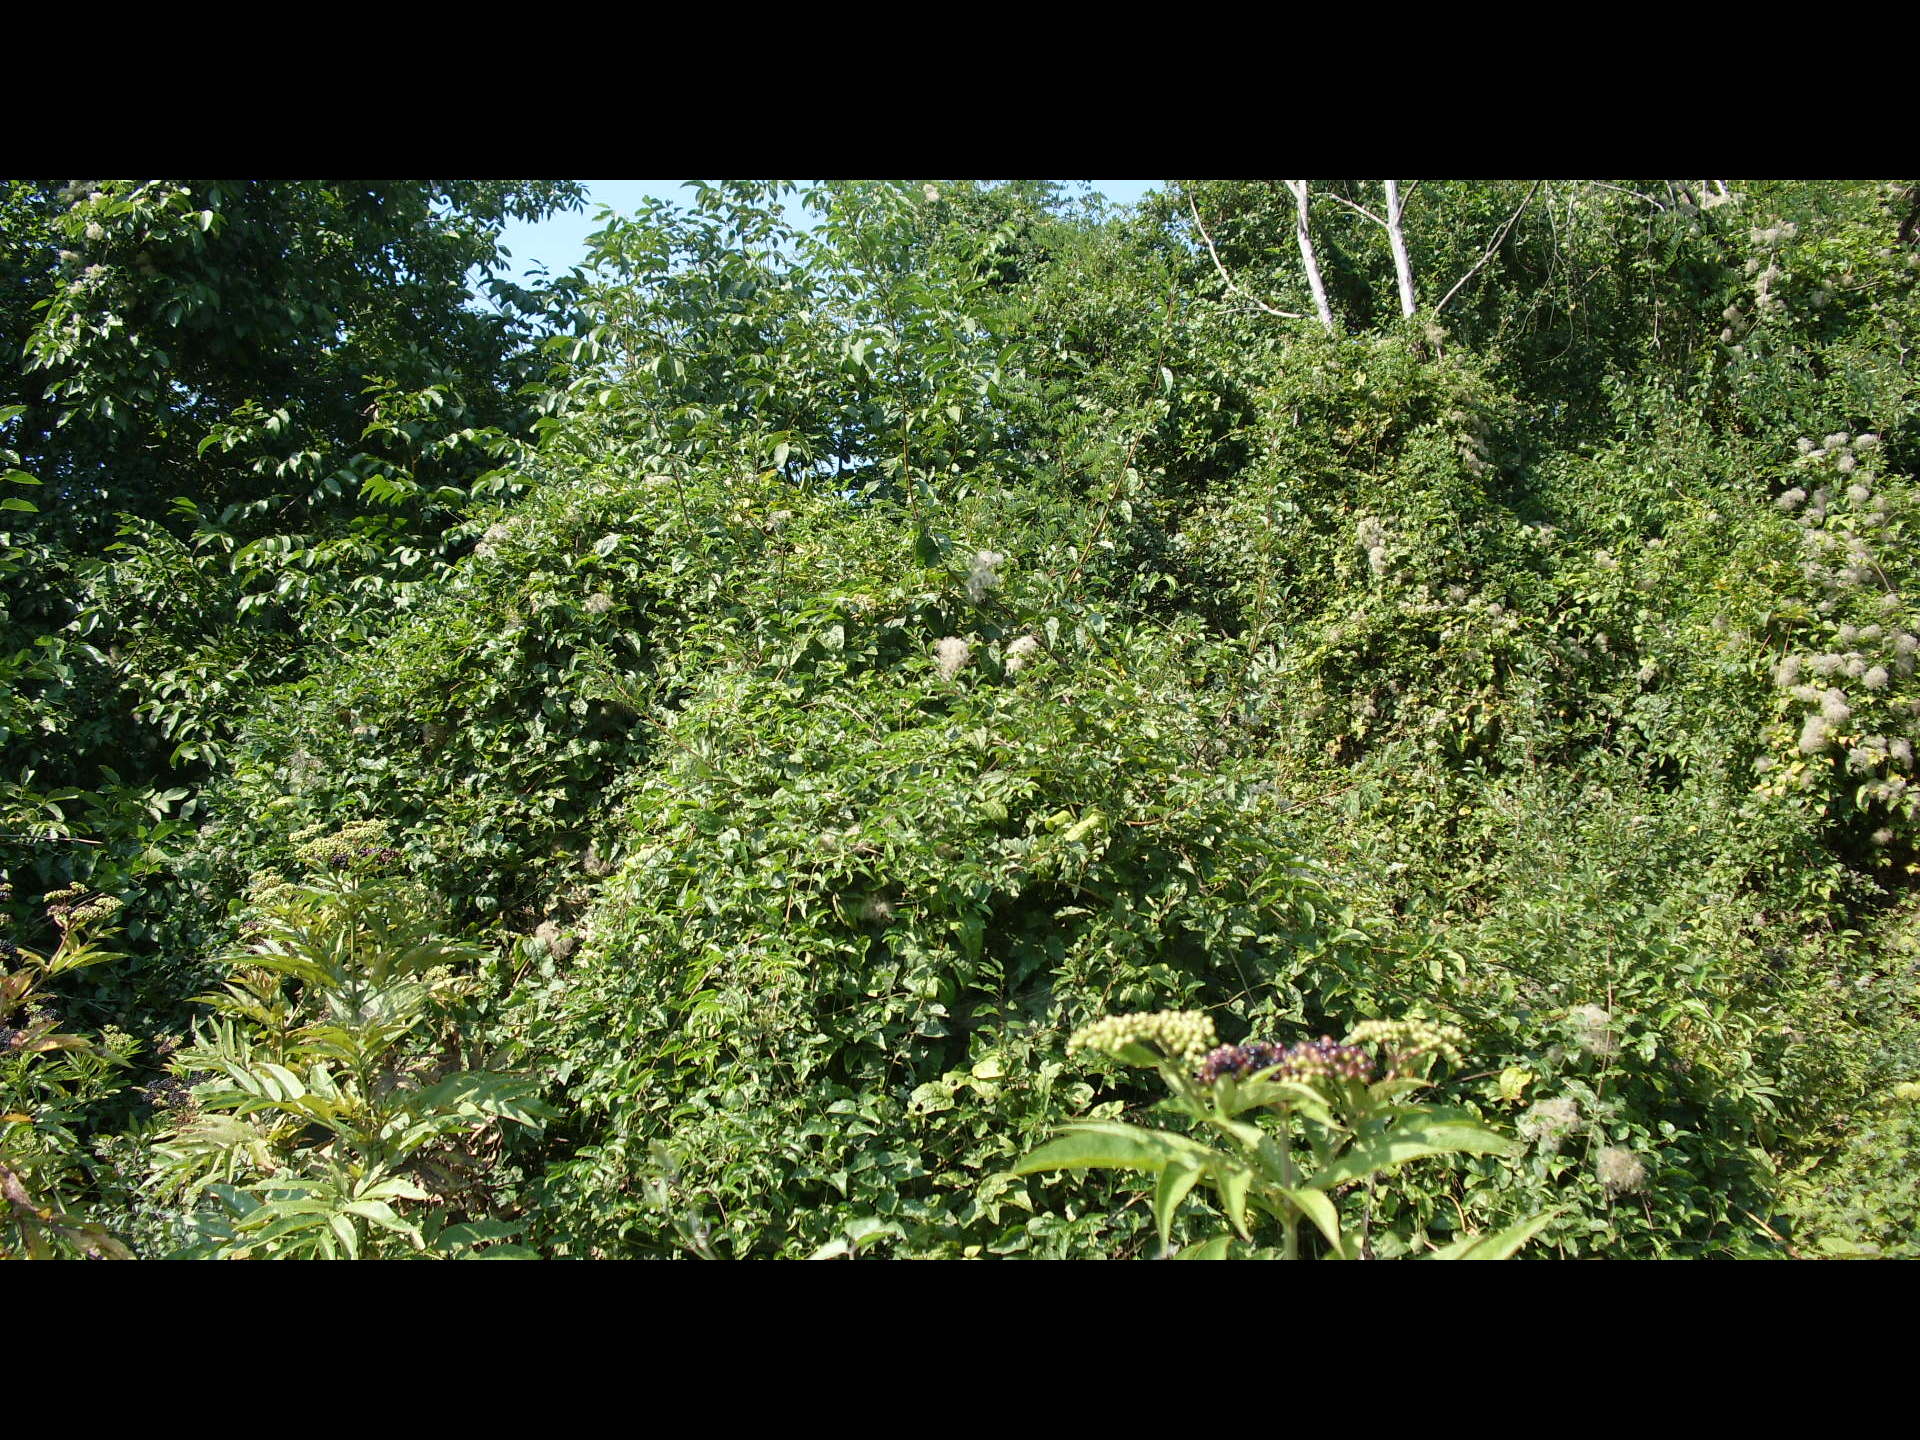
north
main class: Shrubland
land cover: Shrubland with sparse tree cover
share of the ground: > 75 %
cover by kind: shrubs 80 %, herbaceous plants 15 %, broadleaved forest trees 5 %
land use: Community services
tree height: < 5 m
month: August
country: BG
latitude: 44.0698
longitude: 22.7614
